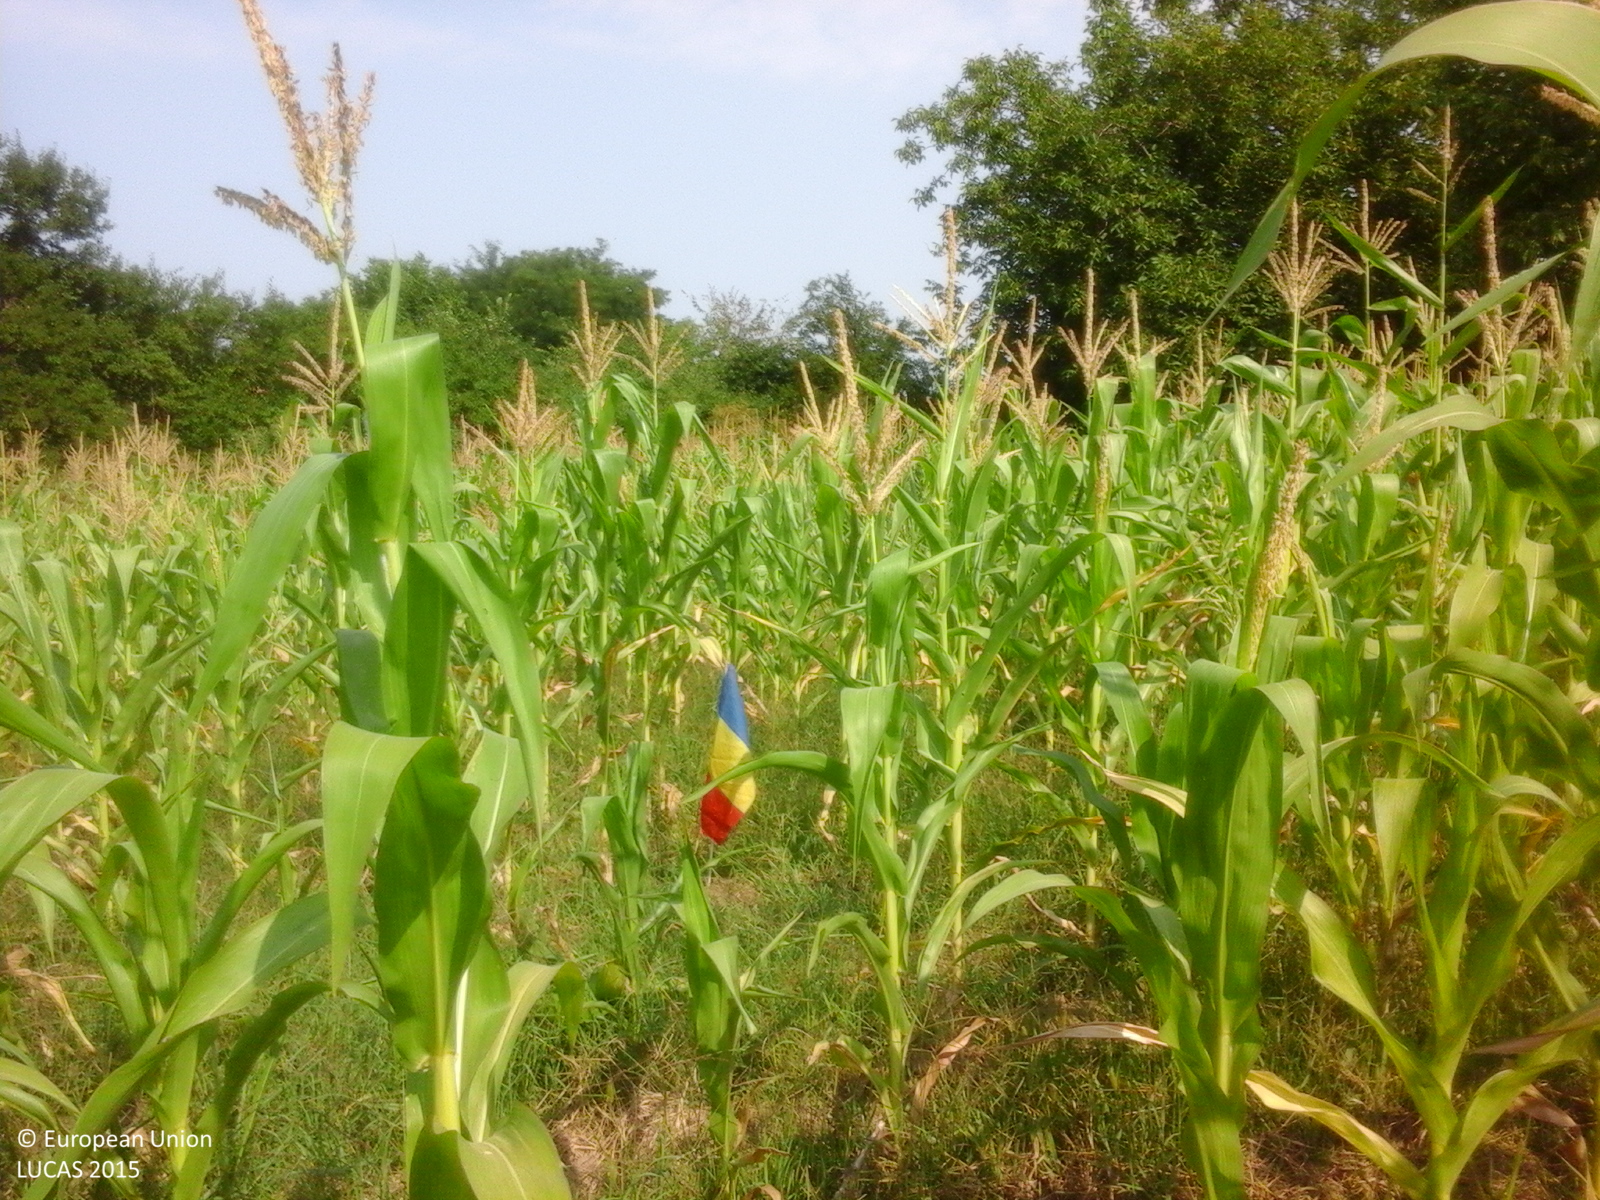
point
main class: Cropland
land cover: Maize
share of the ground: > 75 %
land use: Agriculture (excluding fallow land and kitchen gardens)
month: July
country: RO
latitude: 44.6522
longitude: 26.6268
